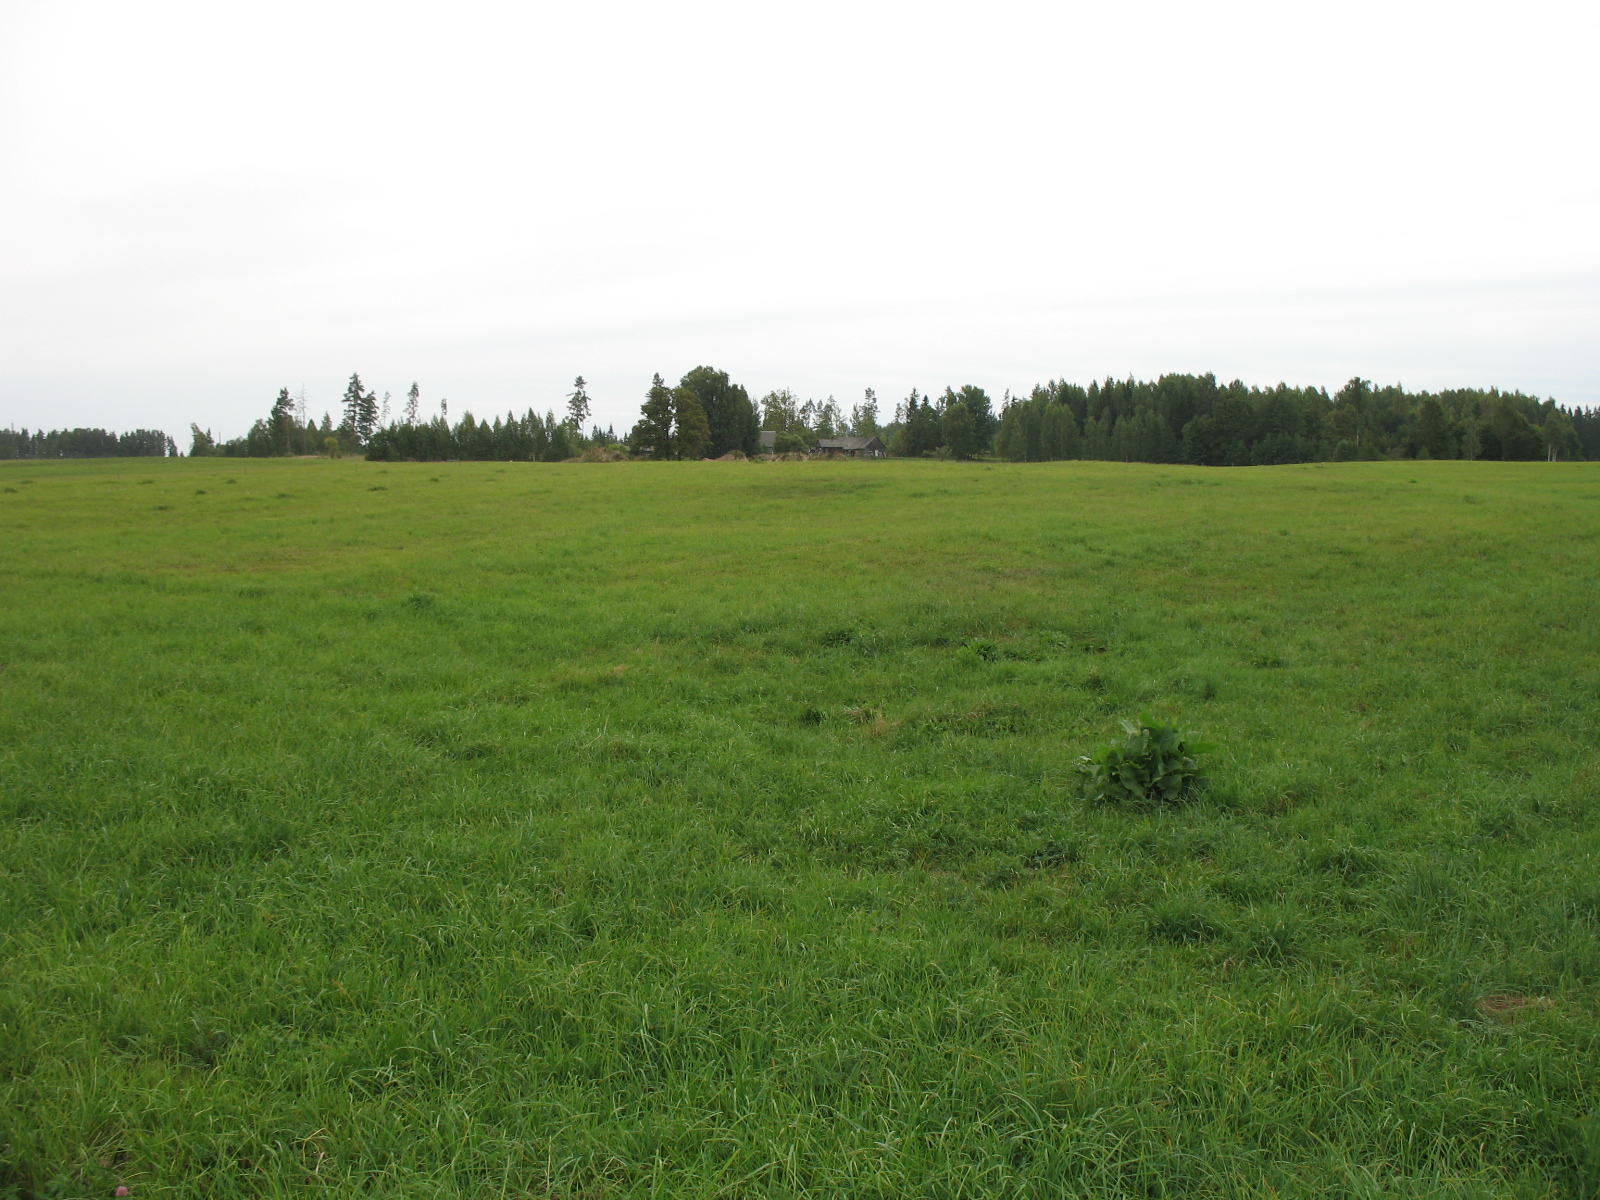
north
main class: Grassland
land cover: Grassland without tree/shrub cover
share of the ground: > 75 %
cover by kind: herbaceous plants 100 %
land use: Agriculture (excluding fallow land and kitchen gardens)
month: September
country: LV
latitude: 56.1990
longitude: 26.1771
